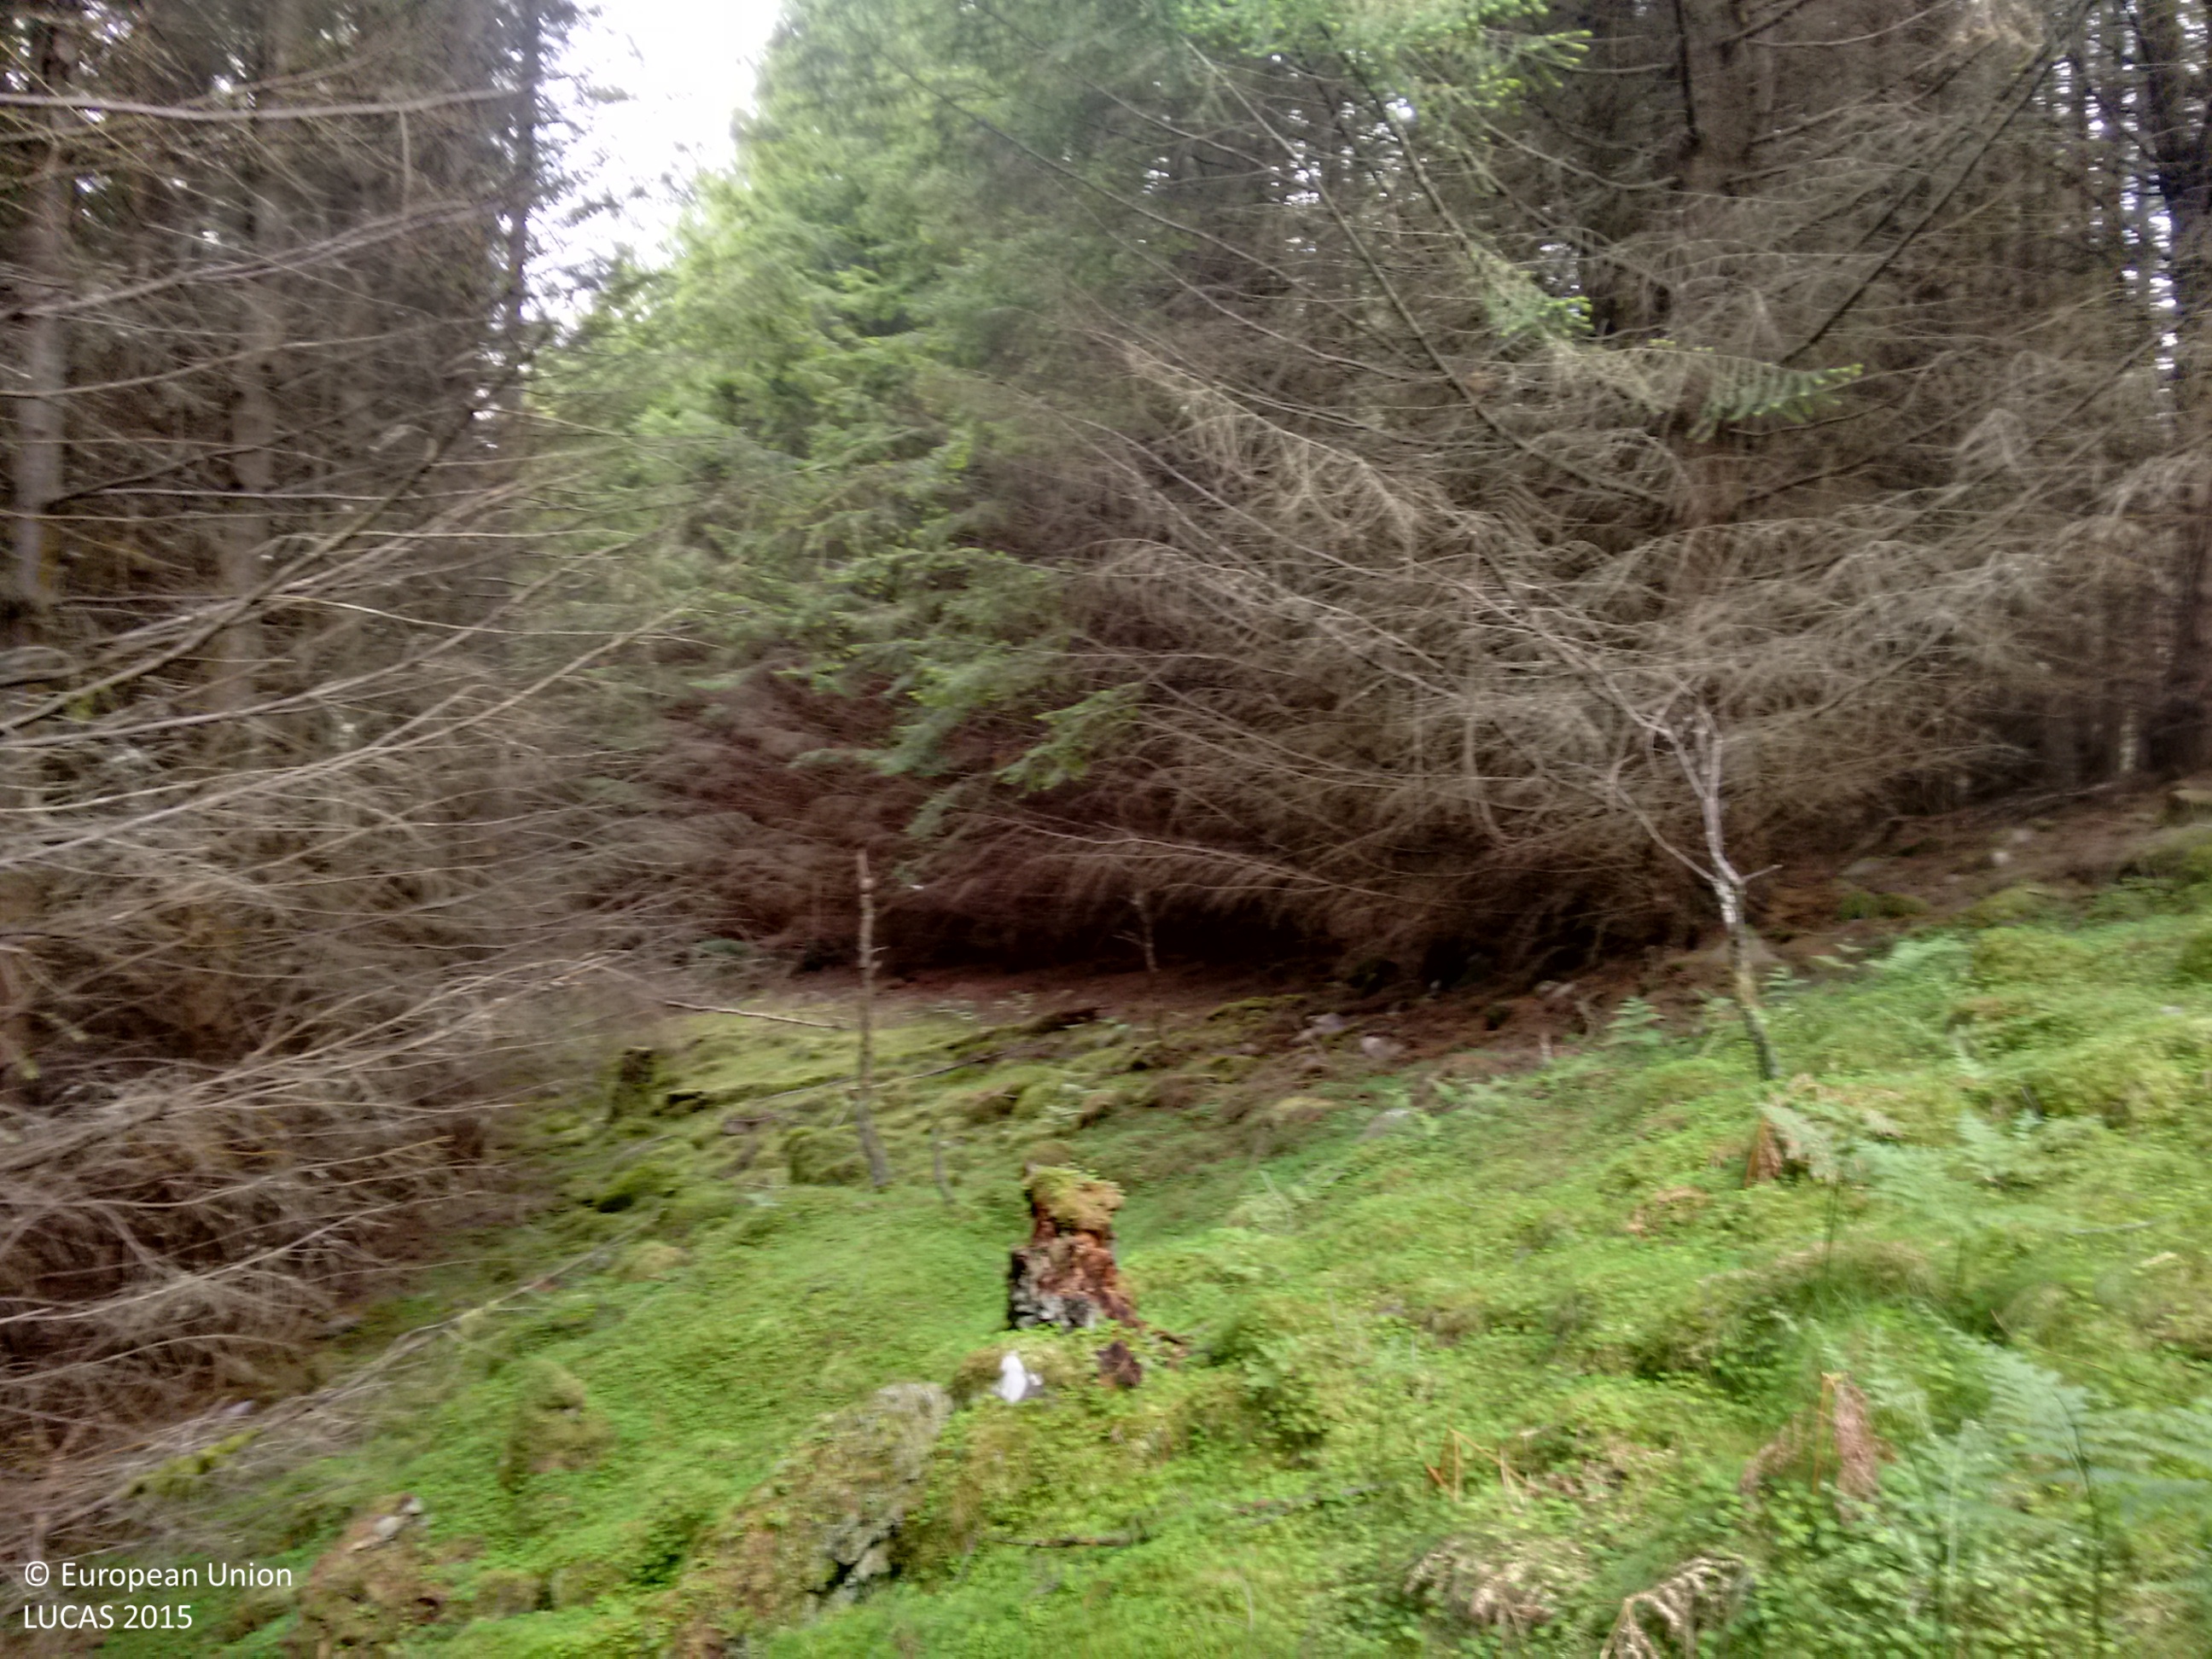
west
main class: Woodland
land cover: Spruce dominated coniferous woodland
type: exotic forest
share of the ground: > 75 %
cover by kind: coniferous forest trees 100 %
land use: Forestry
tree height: > 5 m
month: July
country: GB
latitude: 56.7146
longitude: -3.9873
